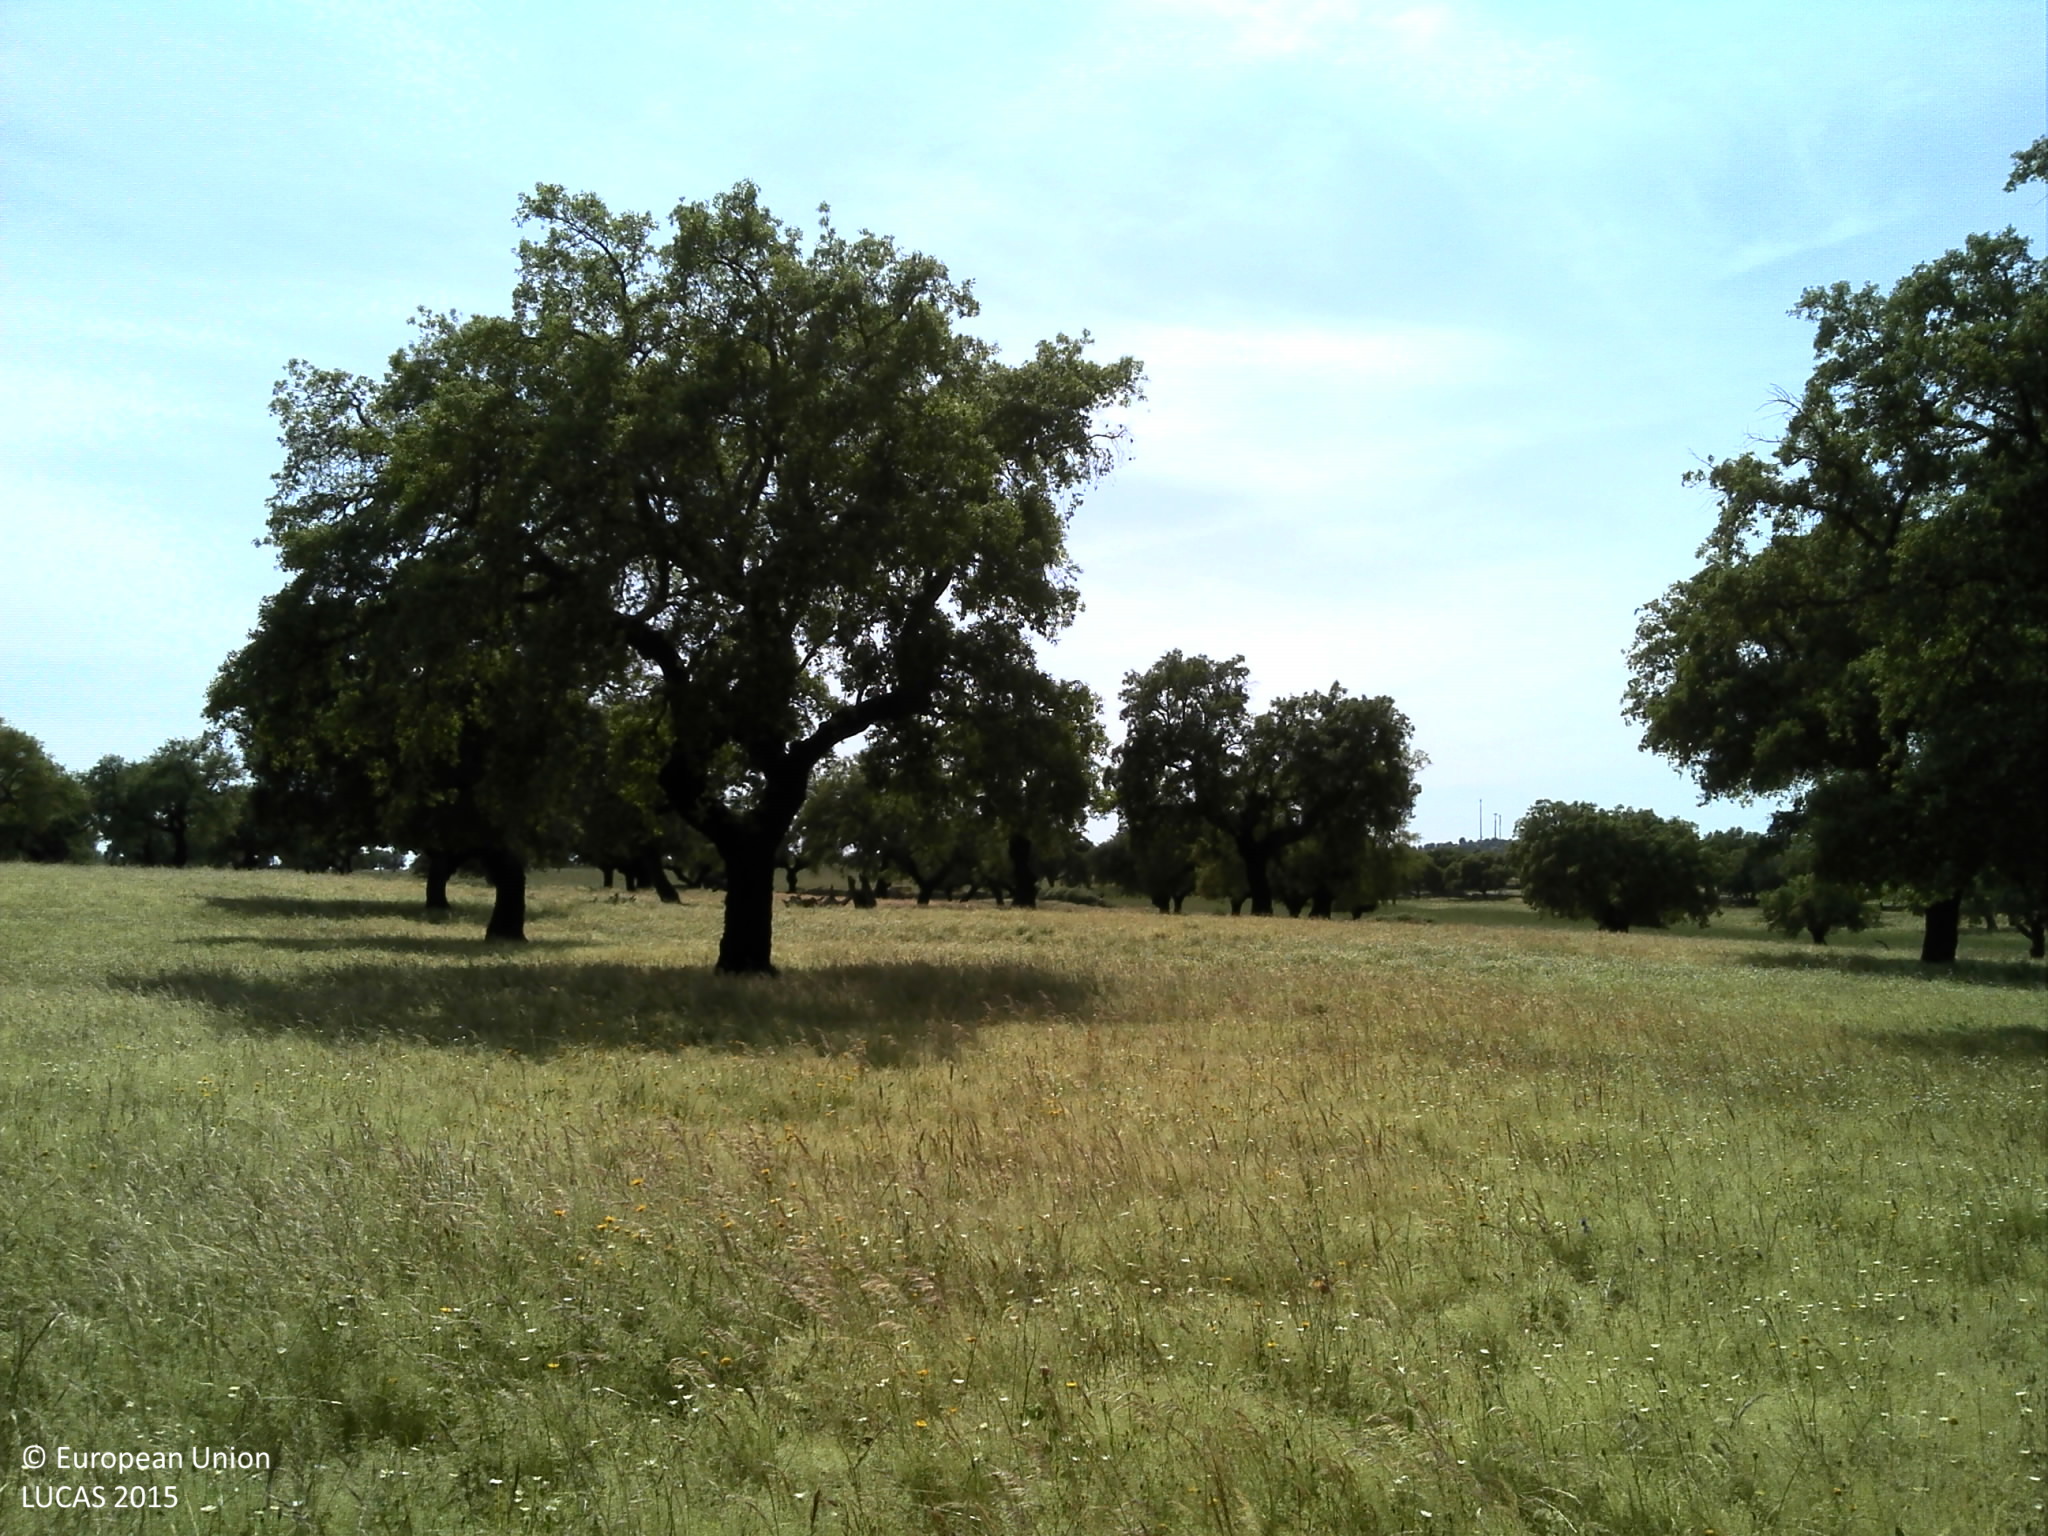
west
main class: Woodland
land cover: Broadleaved woodland
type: broadleaved evergreen forest
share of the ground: 25 - 50 %
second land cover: Grassland without tree/shrub cover
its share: 50 - 75 %
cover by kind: herbaceous plants 50 %, broadleaved forest trees 40 %, unconsolidated bare surface 10 %
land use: Forestry
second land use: Agriculture (excluding fallow land and kitchen gardens)
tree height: > 5 m
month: May
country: PT
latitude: 39.2094
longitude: -7.6362
